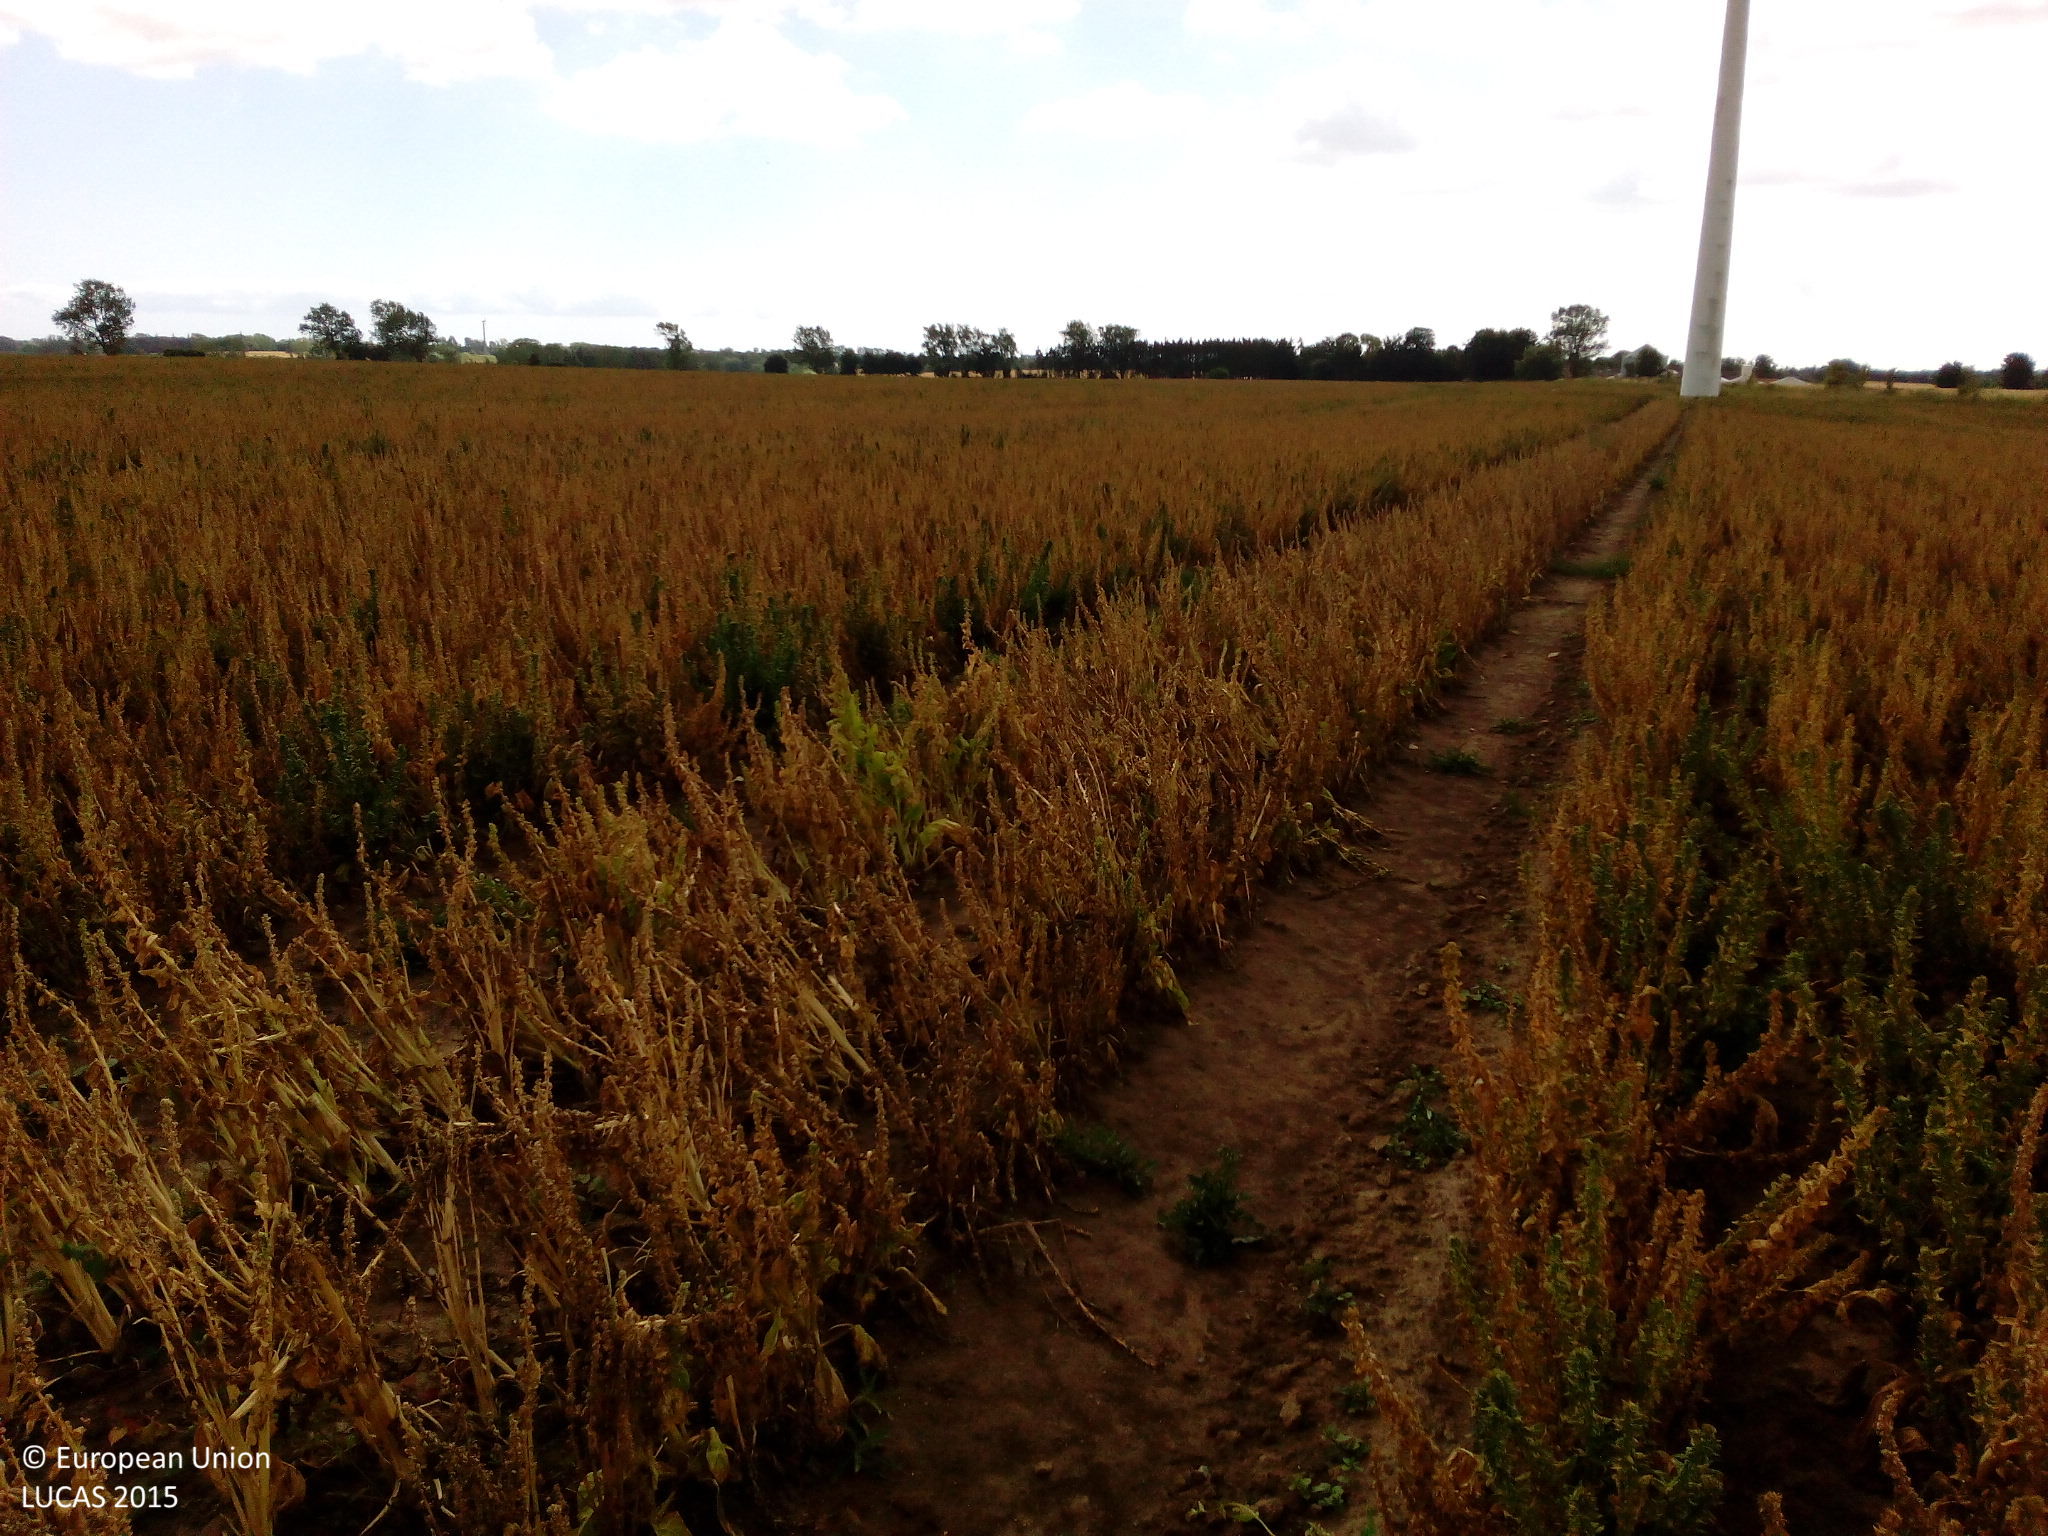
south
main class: Cropland
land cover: Other non-permanent industrial crops
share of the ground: > 75 %
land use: Agriculture (excluding fallow land and kitchen gardens)
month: August
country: DK
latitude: 55.3588
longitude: 12.2541
